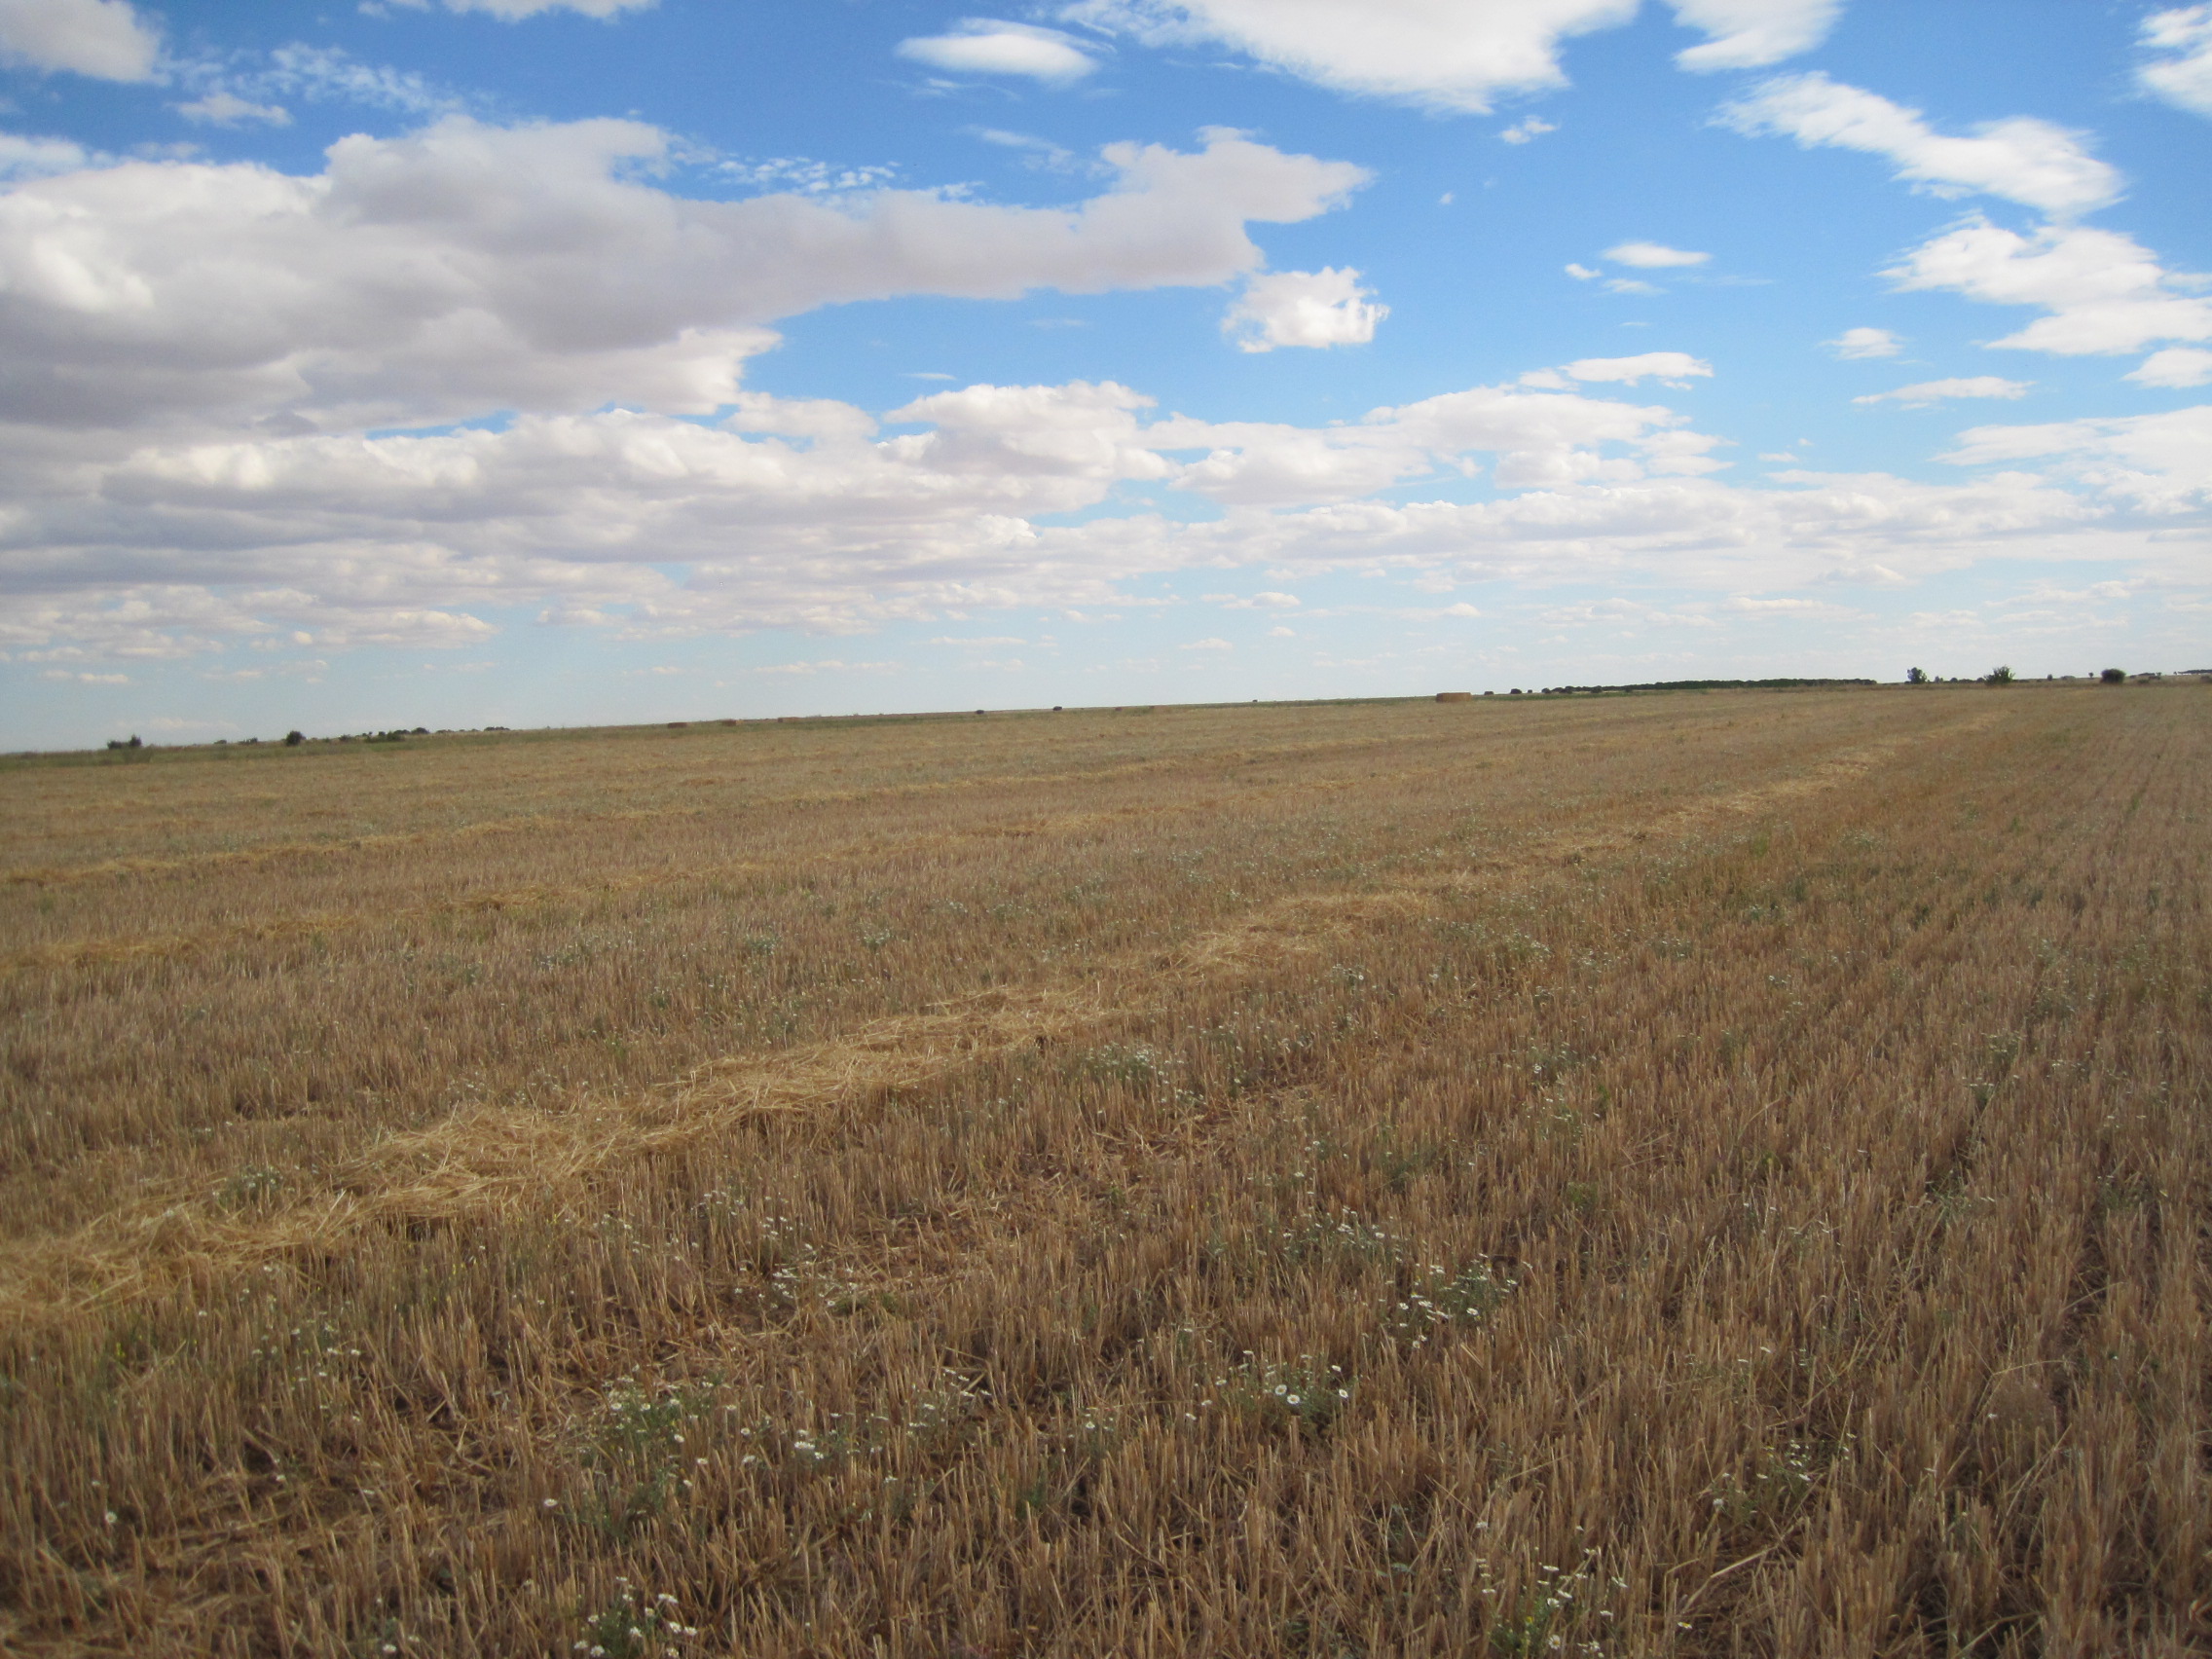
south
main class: Cropland
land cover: Oats
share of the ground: < 10 %
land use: Agriculture (excluding fallow land and kitchen gardens)
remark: Harvested field
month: July
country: ES
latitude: 42.0375
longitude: -5.5149
